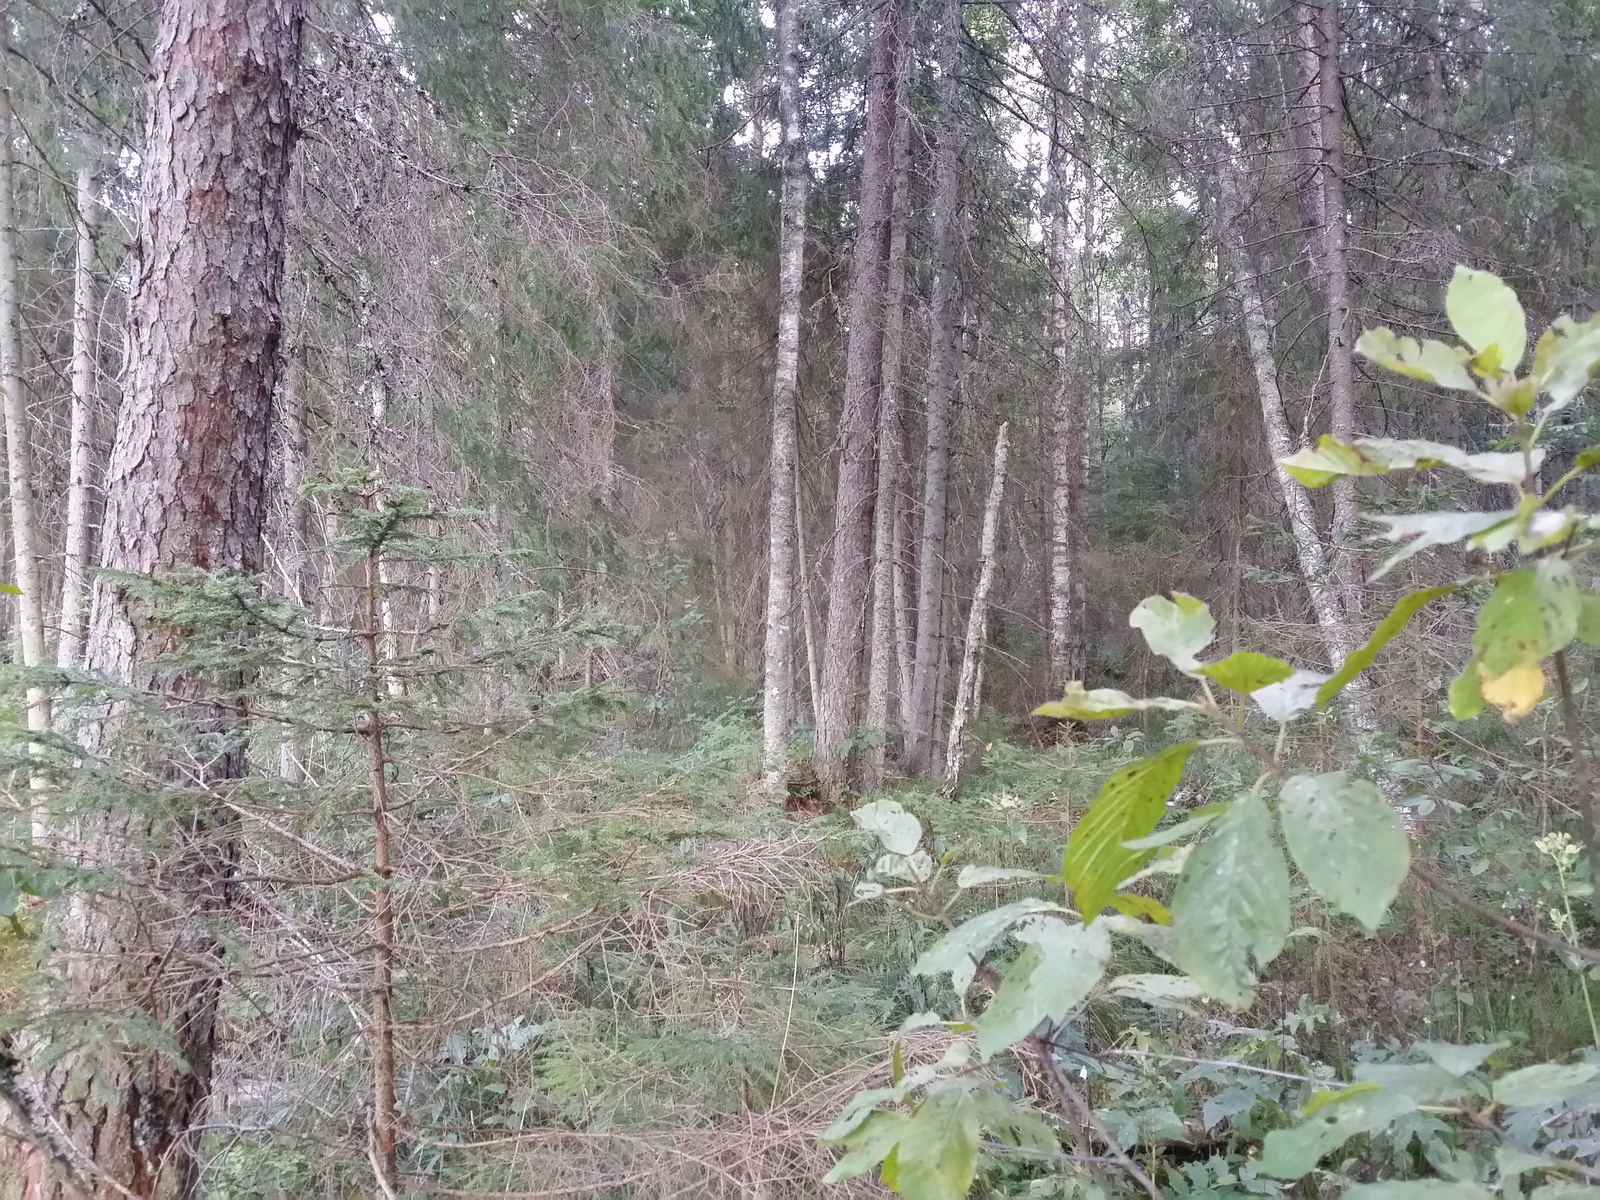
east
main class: Woodland
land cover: Other mixed woodland
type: hemiboreal forest and nemoral coniferous forest and mixed broadleaved-coniferous forest
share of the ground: > 75 %
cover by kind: coniferous forest trees 55 %, broadleaved forest trees 25 %, herbaceous plants 10 %, lichens and mosses 10 %
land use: Forestry
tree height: > 5 m
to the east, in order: Other mixed woodland; Spruce dominated mixed woodland; Shrubland with sparse tree cover; Ditches and canals; Shrubland with sparse tree cover; Broadleaved woodland
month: August
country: LV
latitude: 57.5017
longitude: 26.7891
